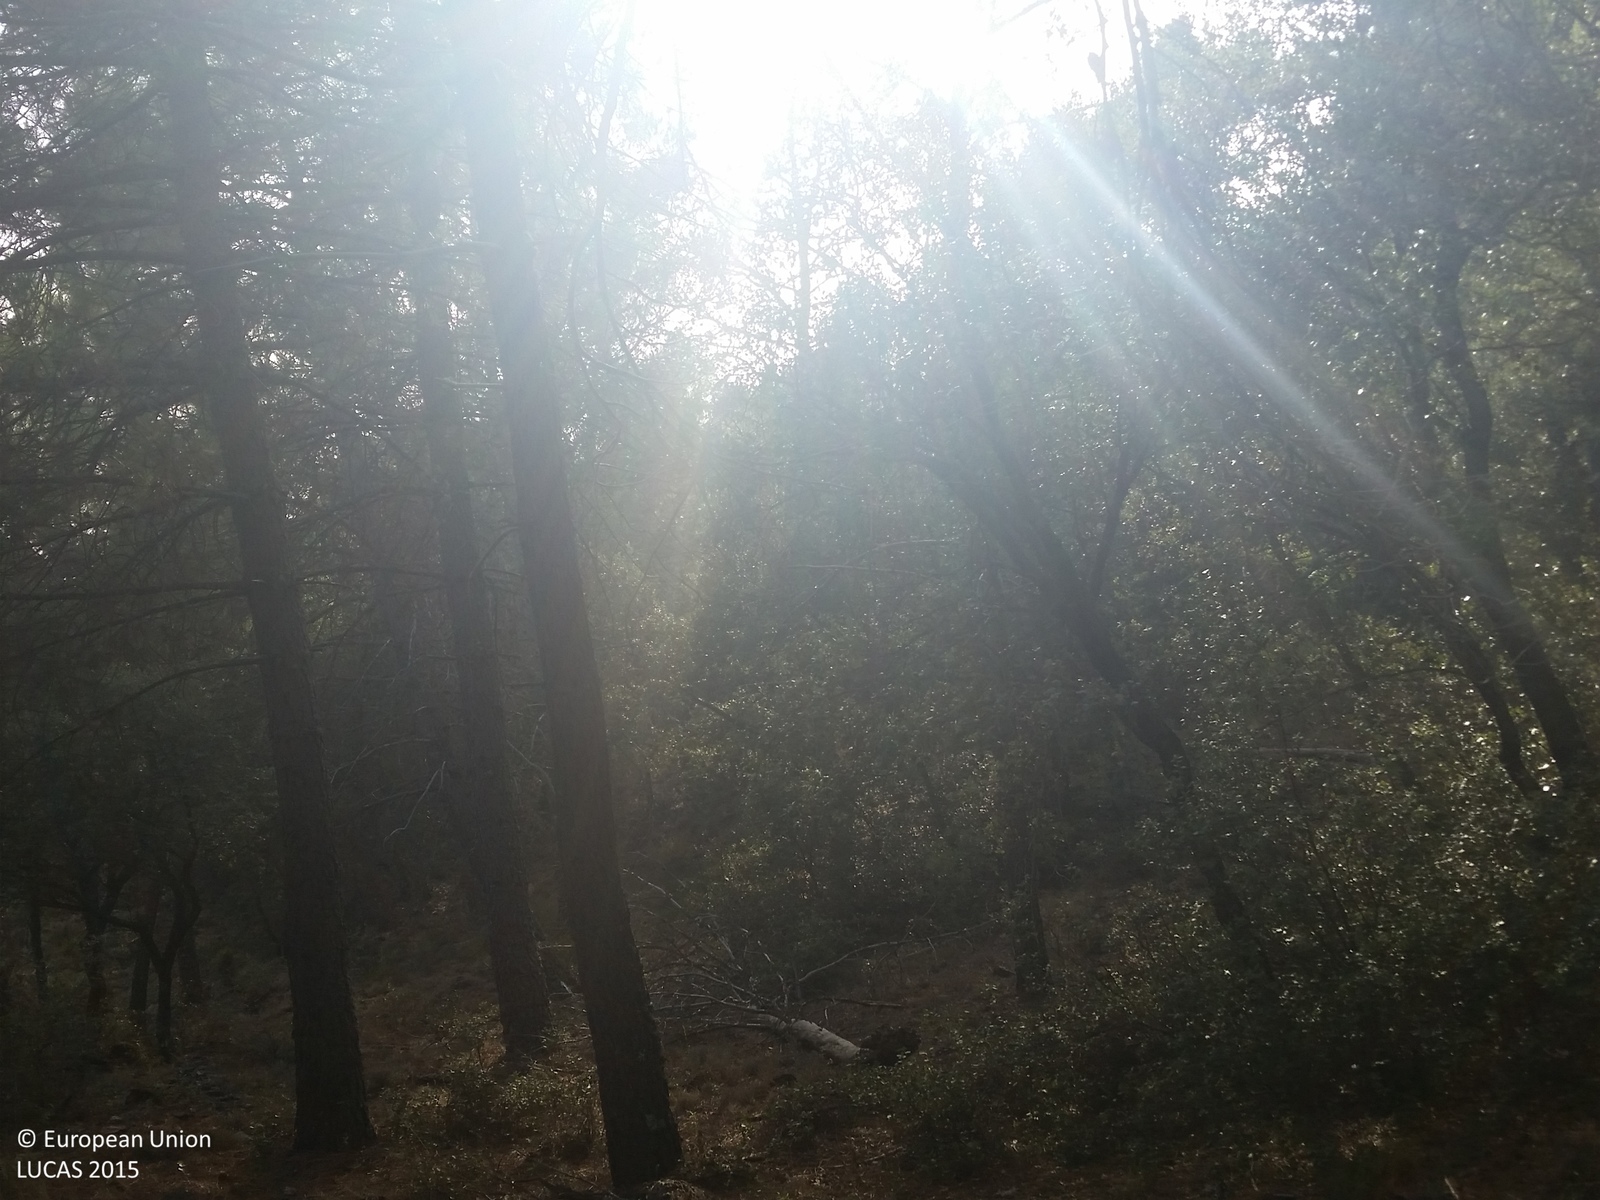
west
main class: Woodland
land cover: Pine dominated coniferous woodland
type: coniferous forest of the mediterranean region
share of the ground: > 75 %
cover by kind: coniferous forest trees 80 %, shrubs 20 %
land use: Forestry
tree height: > 5 m
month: August
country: ES
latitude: 38.5354
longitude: -2.6081
